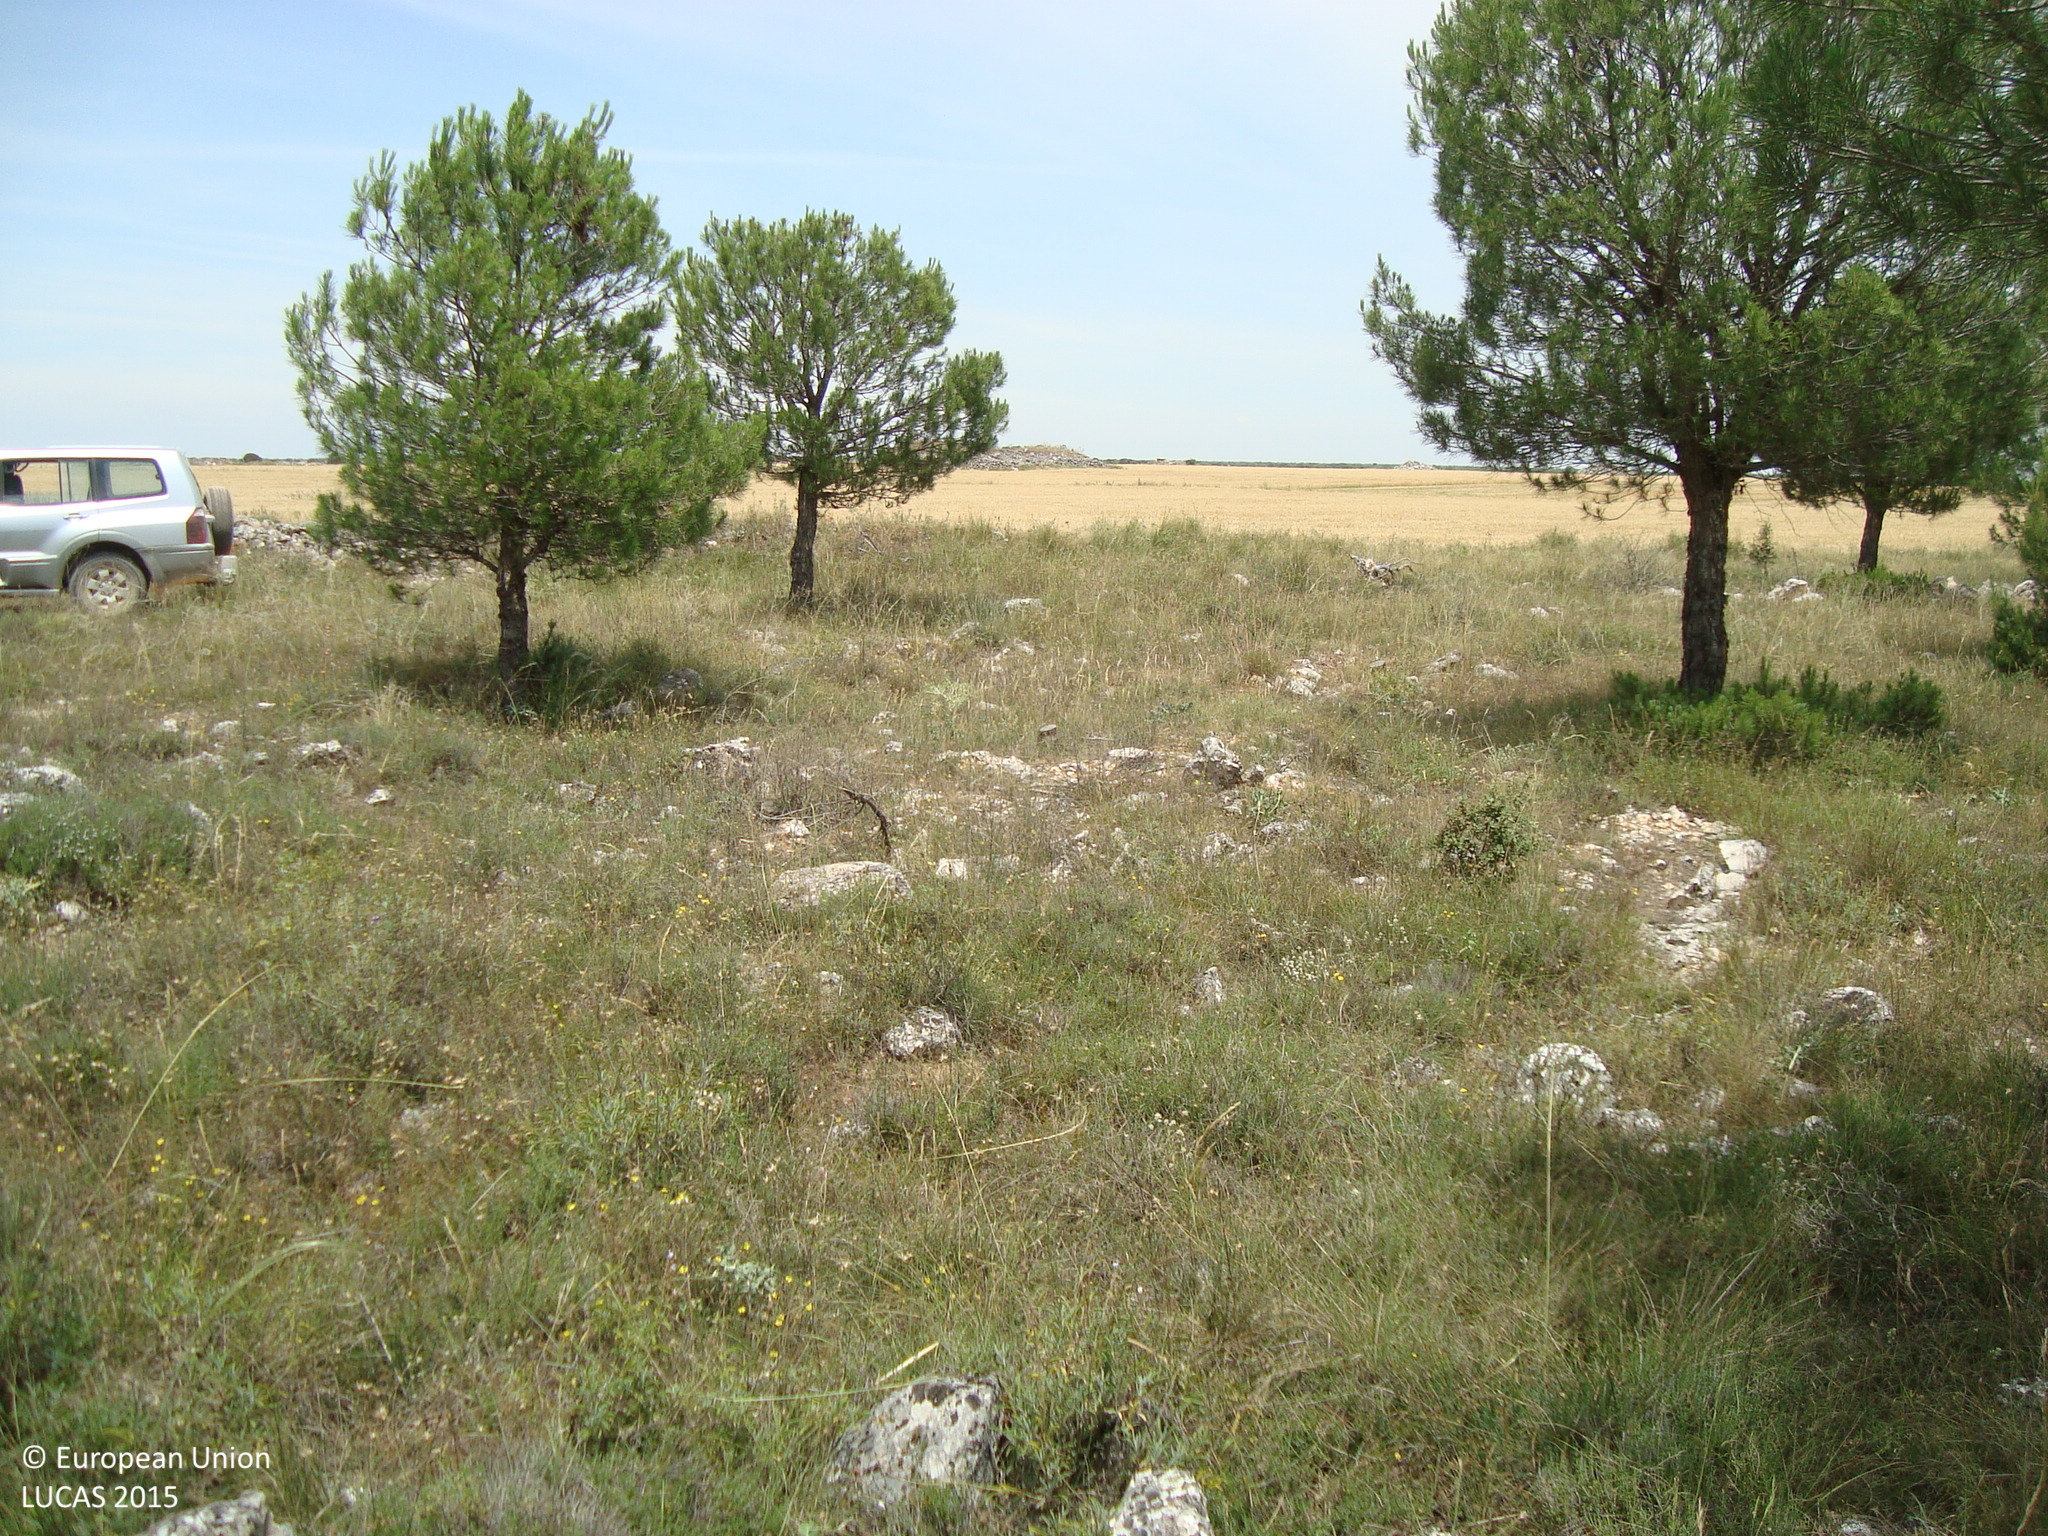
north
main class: Woodland
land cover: Pine dominated coniferous woodland
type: coniferous forest of the mediterranean region
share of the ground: 10 - 25 %
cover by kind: shrubs 60 %, coniferous forest trees 20 %, herbaceous plants 10 %, broadleaved forest trees 5 %, unconsolidated bare surface 5 %
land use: Forestry
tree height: > 5 m
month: July
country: ES
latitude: 41.8041
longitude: -4.1311
